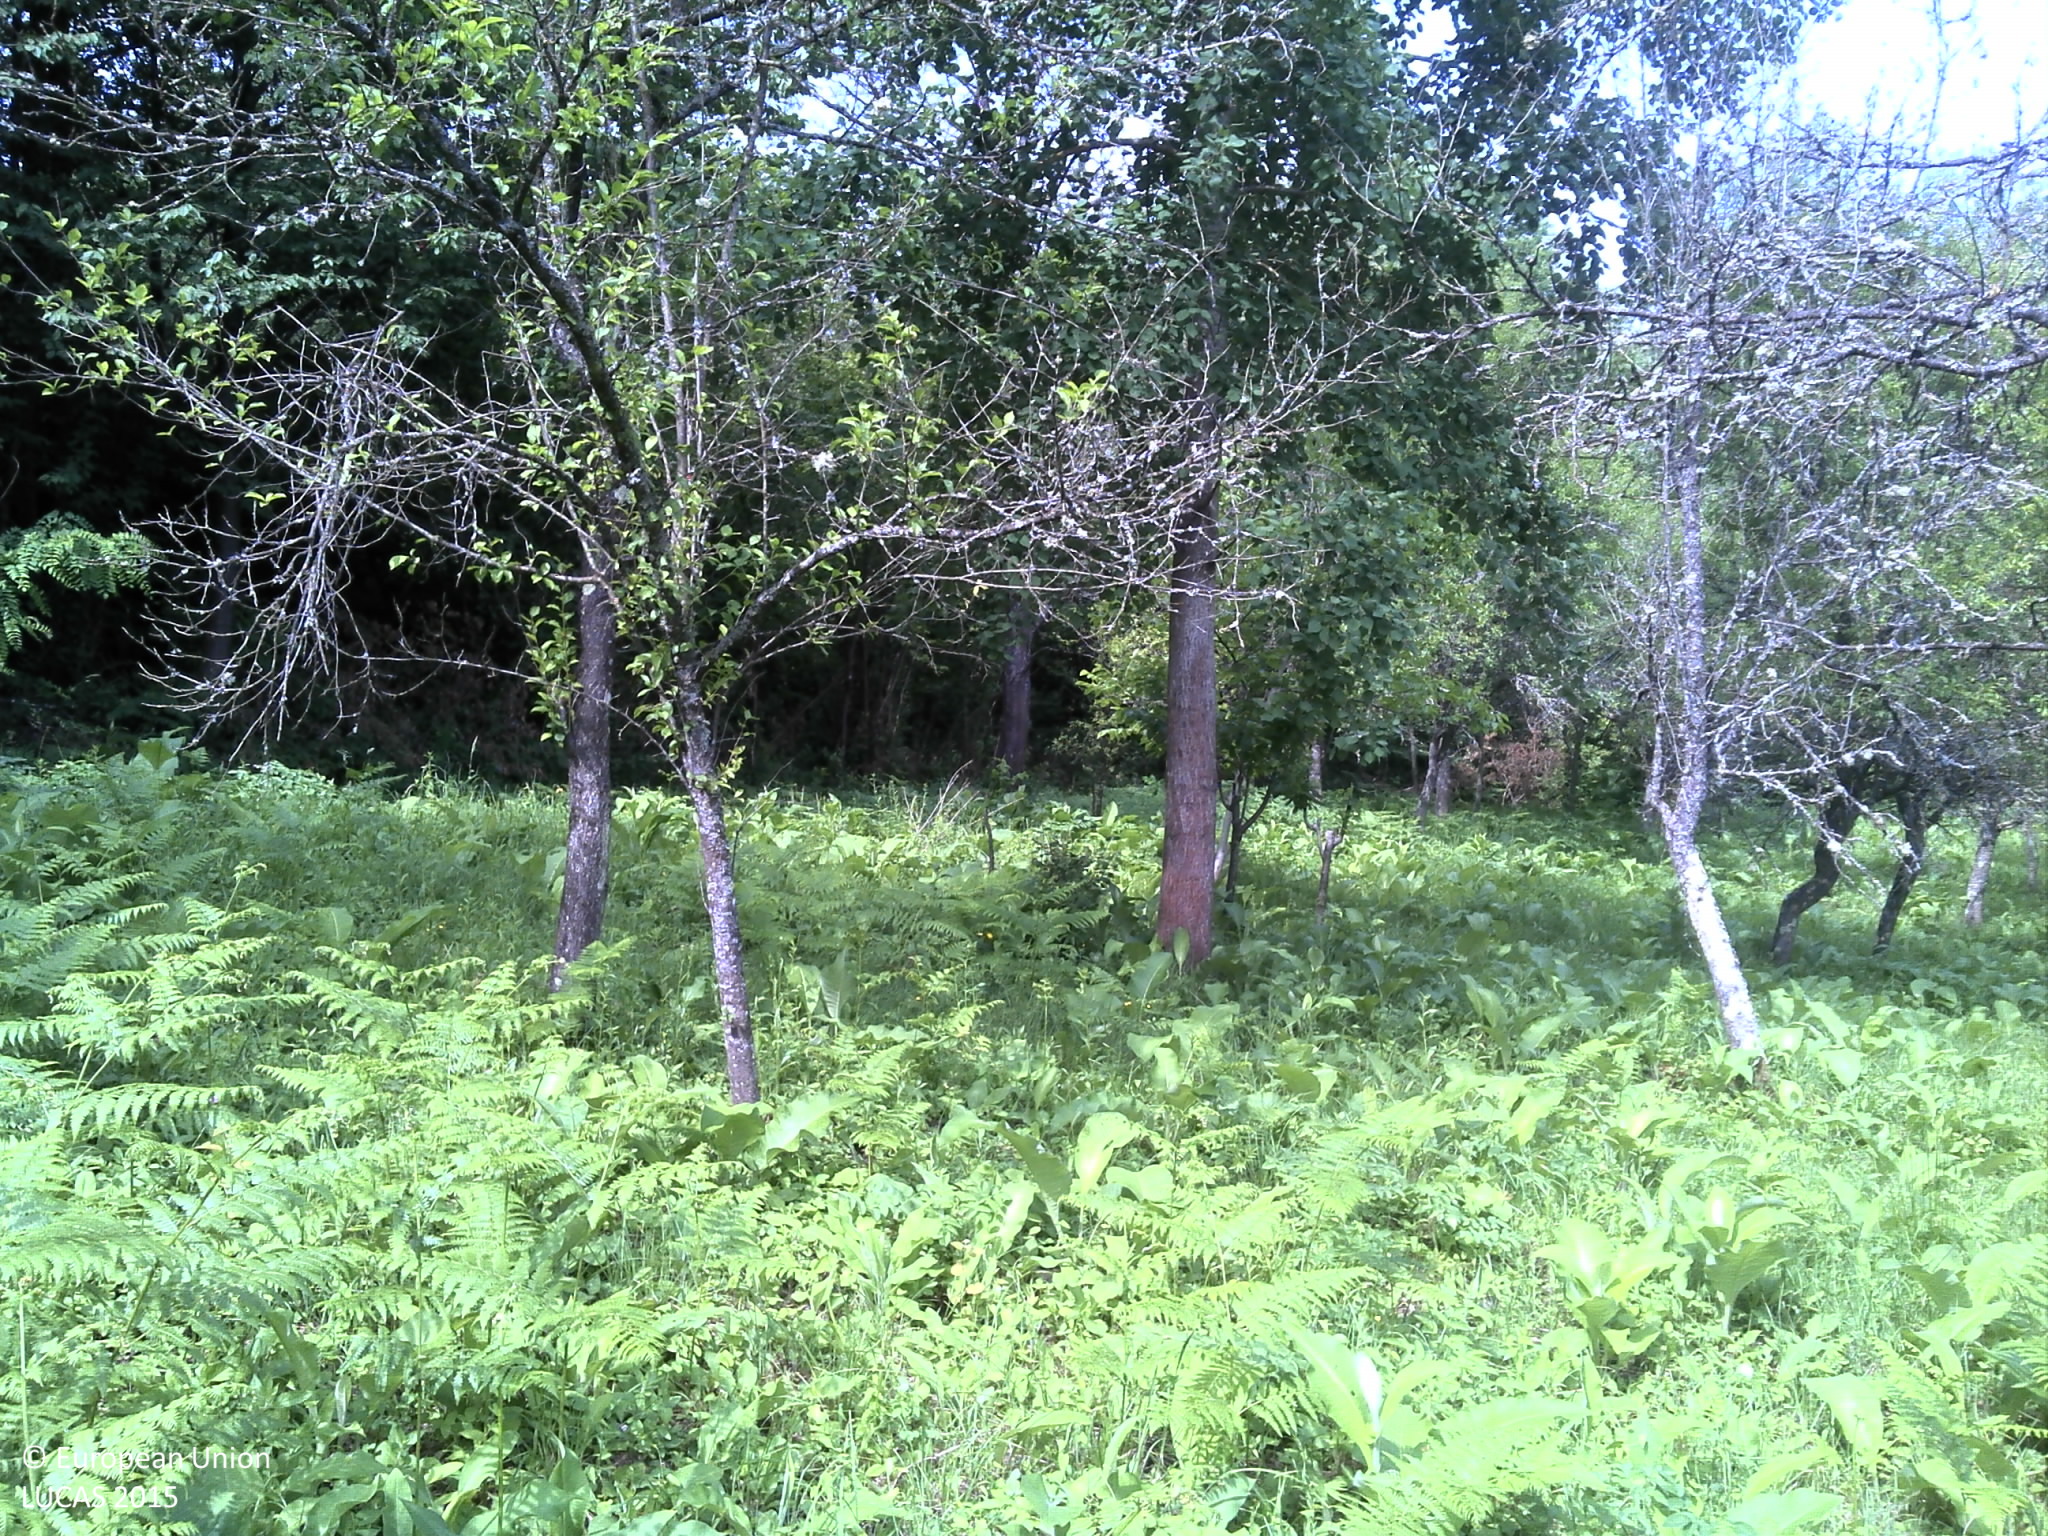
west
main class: Cropland
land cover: Other fruit trees and berries
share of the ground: > 75 %
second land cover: Grassland without tree/shrub cover
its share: > 75 %
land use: Agriculture (excluding fallow land and kitchen gardens)
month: June
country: HR
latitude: 45.3195
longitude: 17.6172
